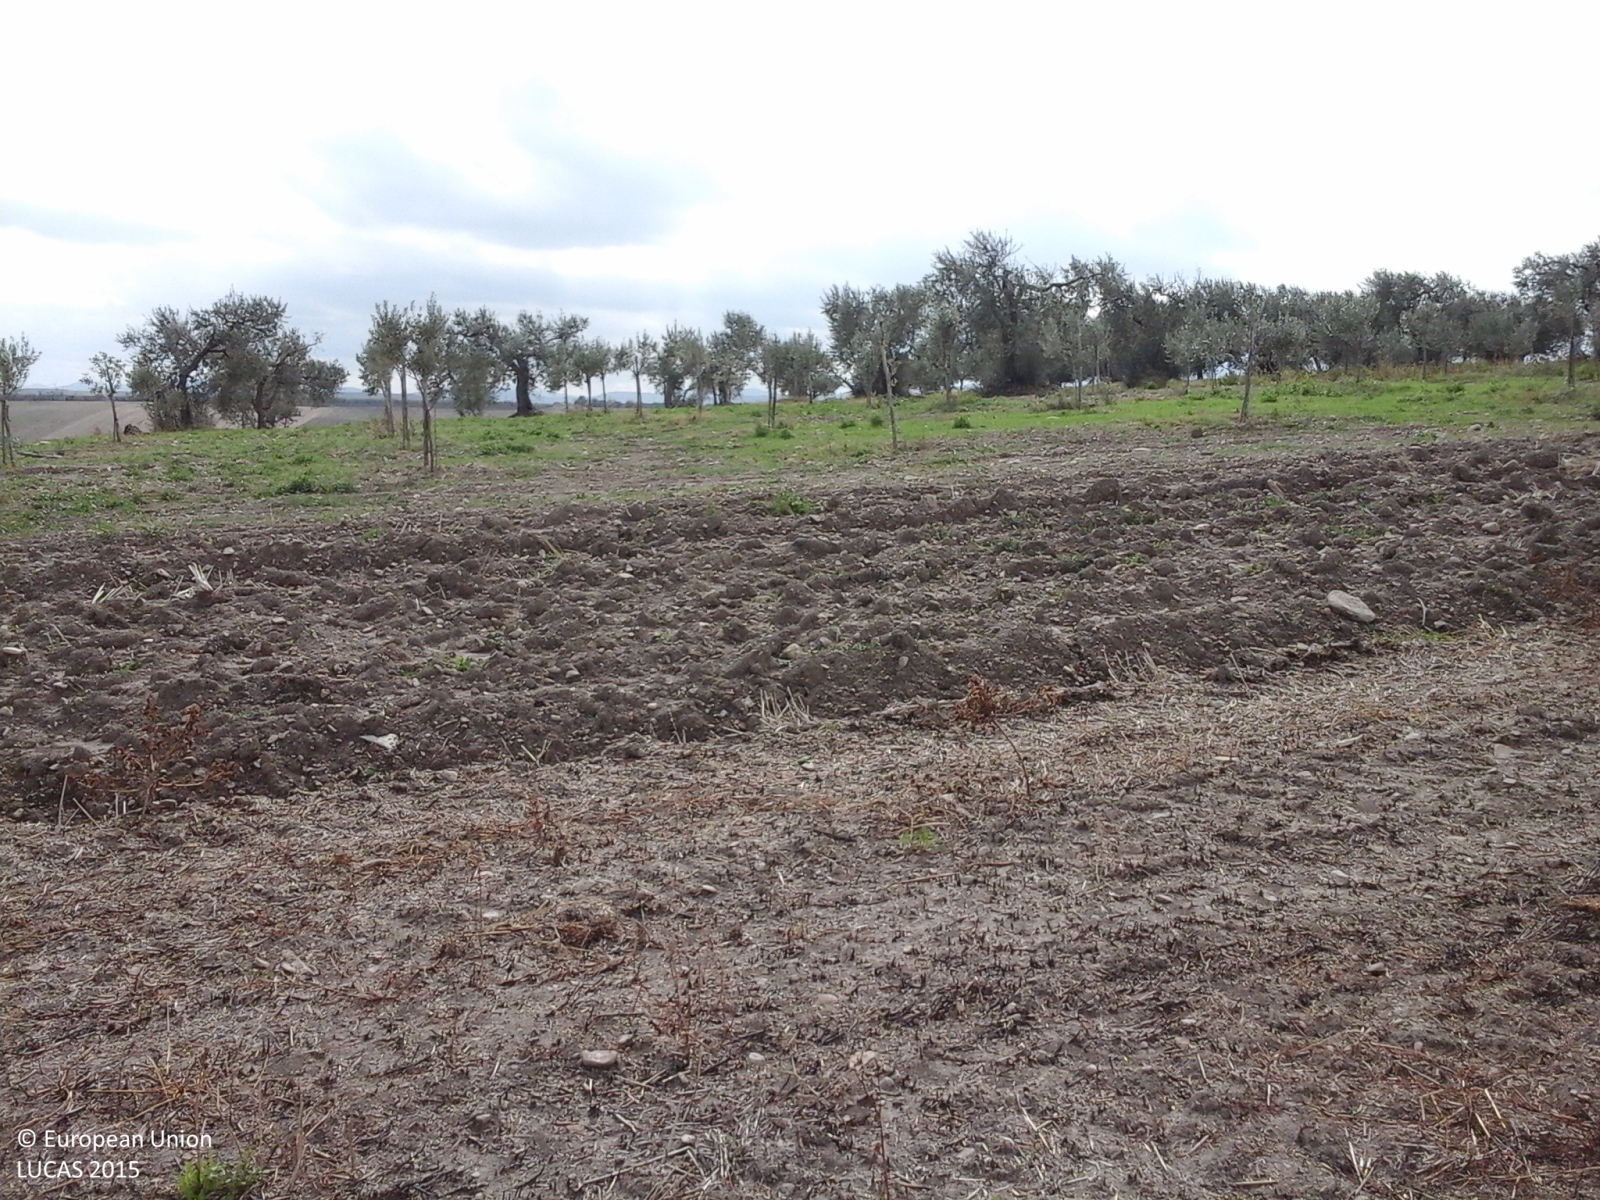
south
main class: Cropland
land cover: Durum wheat
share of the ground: > 75 %
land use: Agriculture (excluding fallow land and kitchen gardens)
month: October
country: IT
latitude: 41.4710
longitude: 15.1912
